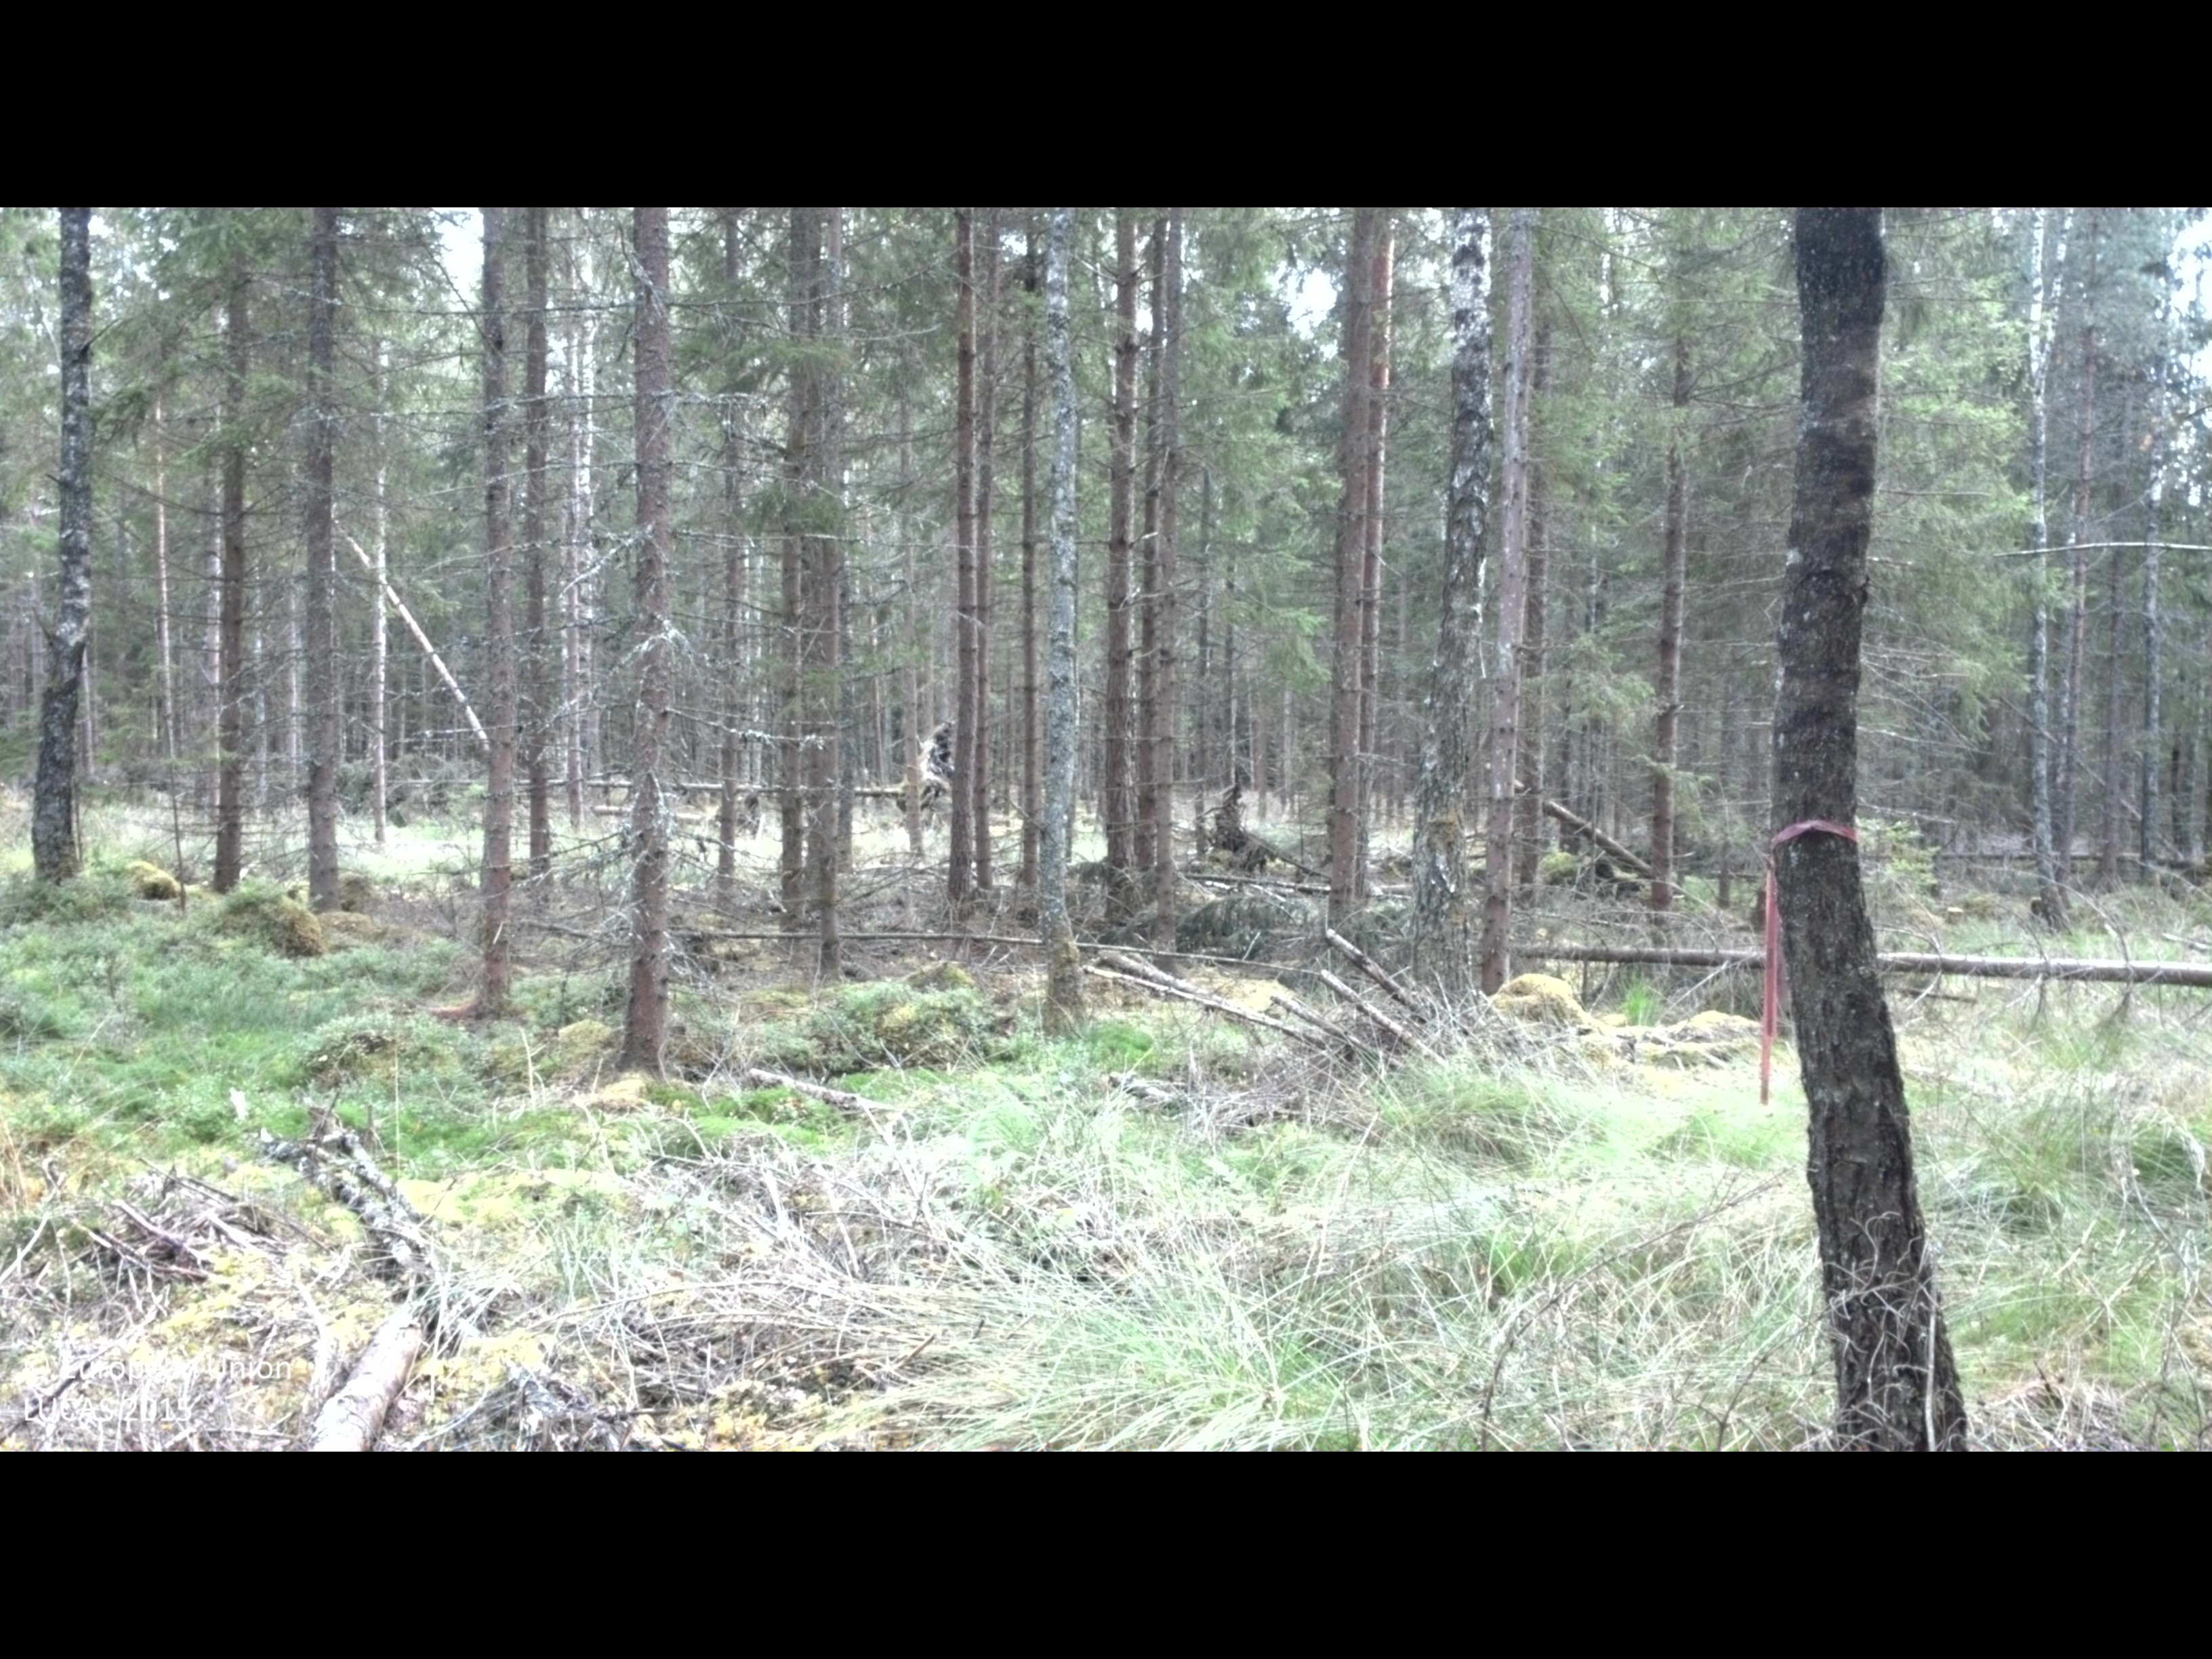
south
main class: Woodland
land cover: Spruce dominated coniferous woodland
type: boreal forest
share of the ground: 50 - 75 %
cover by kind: coniferous forest trees 60 %, shrubs 20 %, broadleaved forest trees 15 %, herbaceous plants 5 %
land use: Forestry
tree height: > 5 m
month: August
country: SE
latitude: 57.1731
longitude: 13.8828
